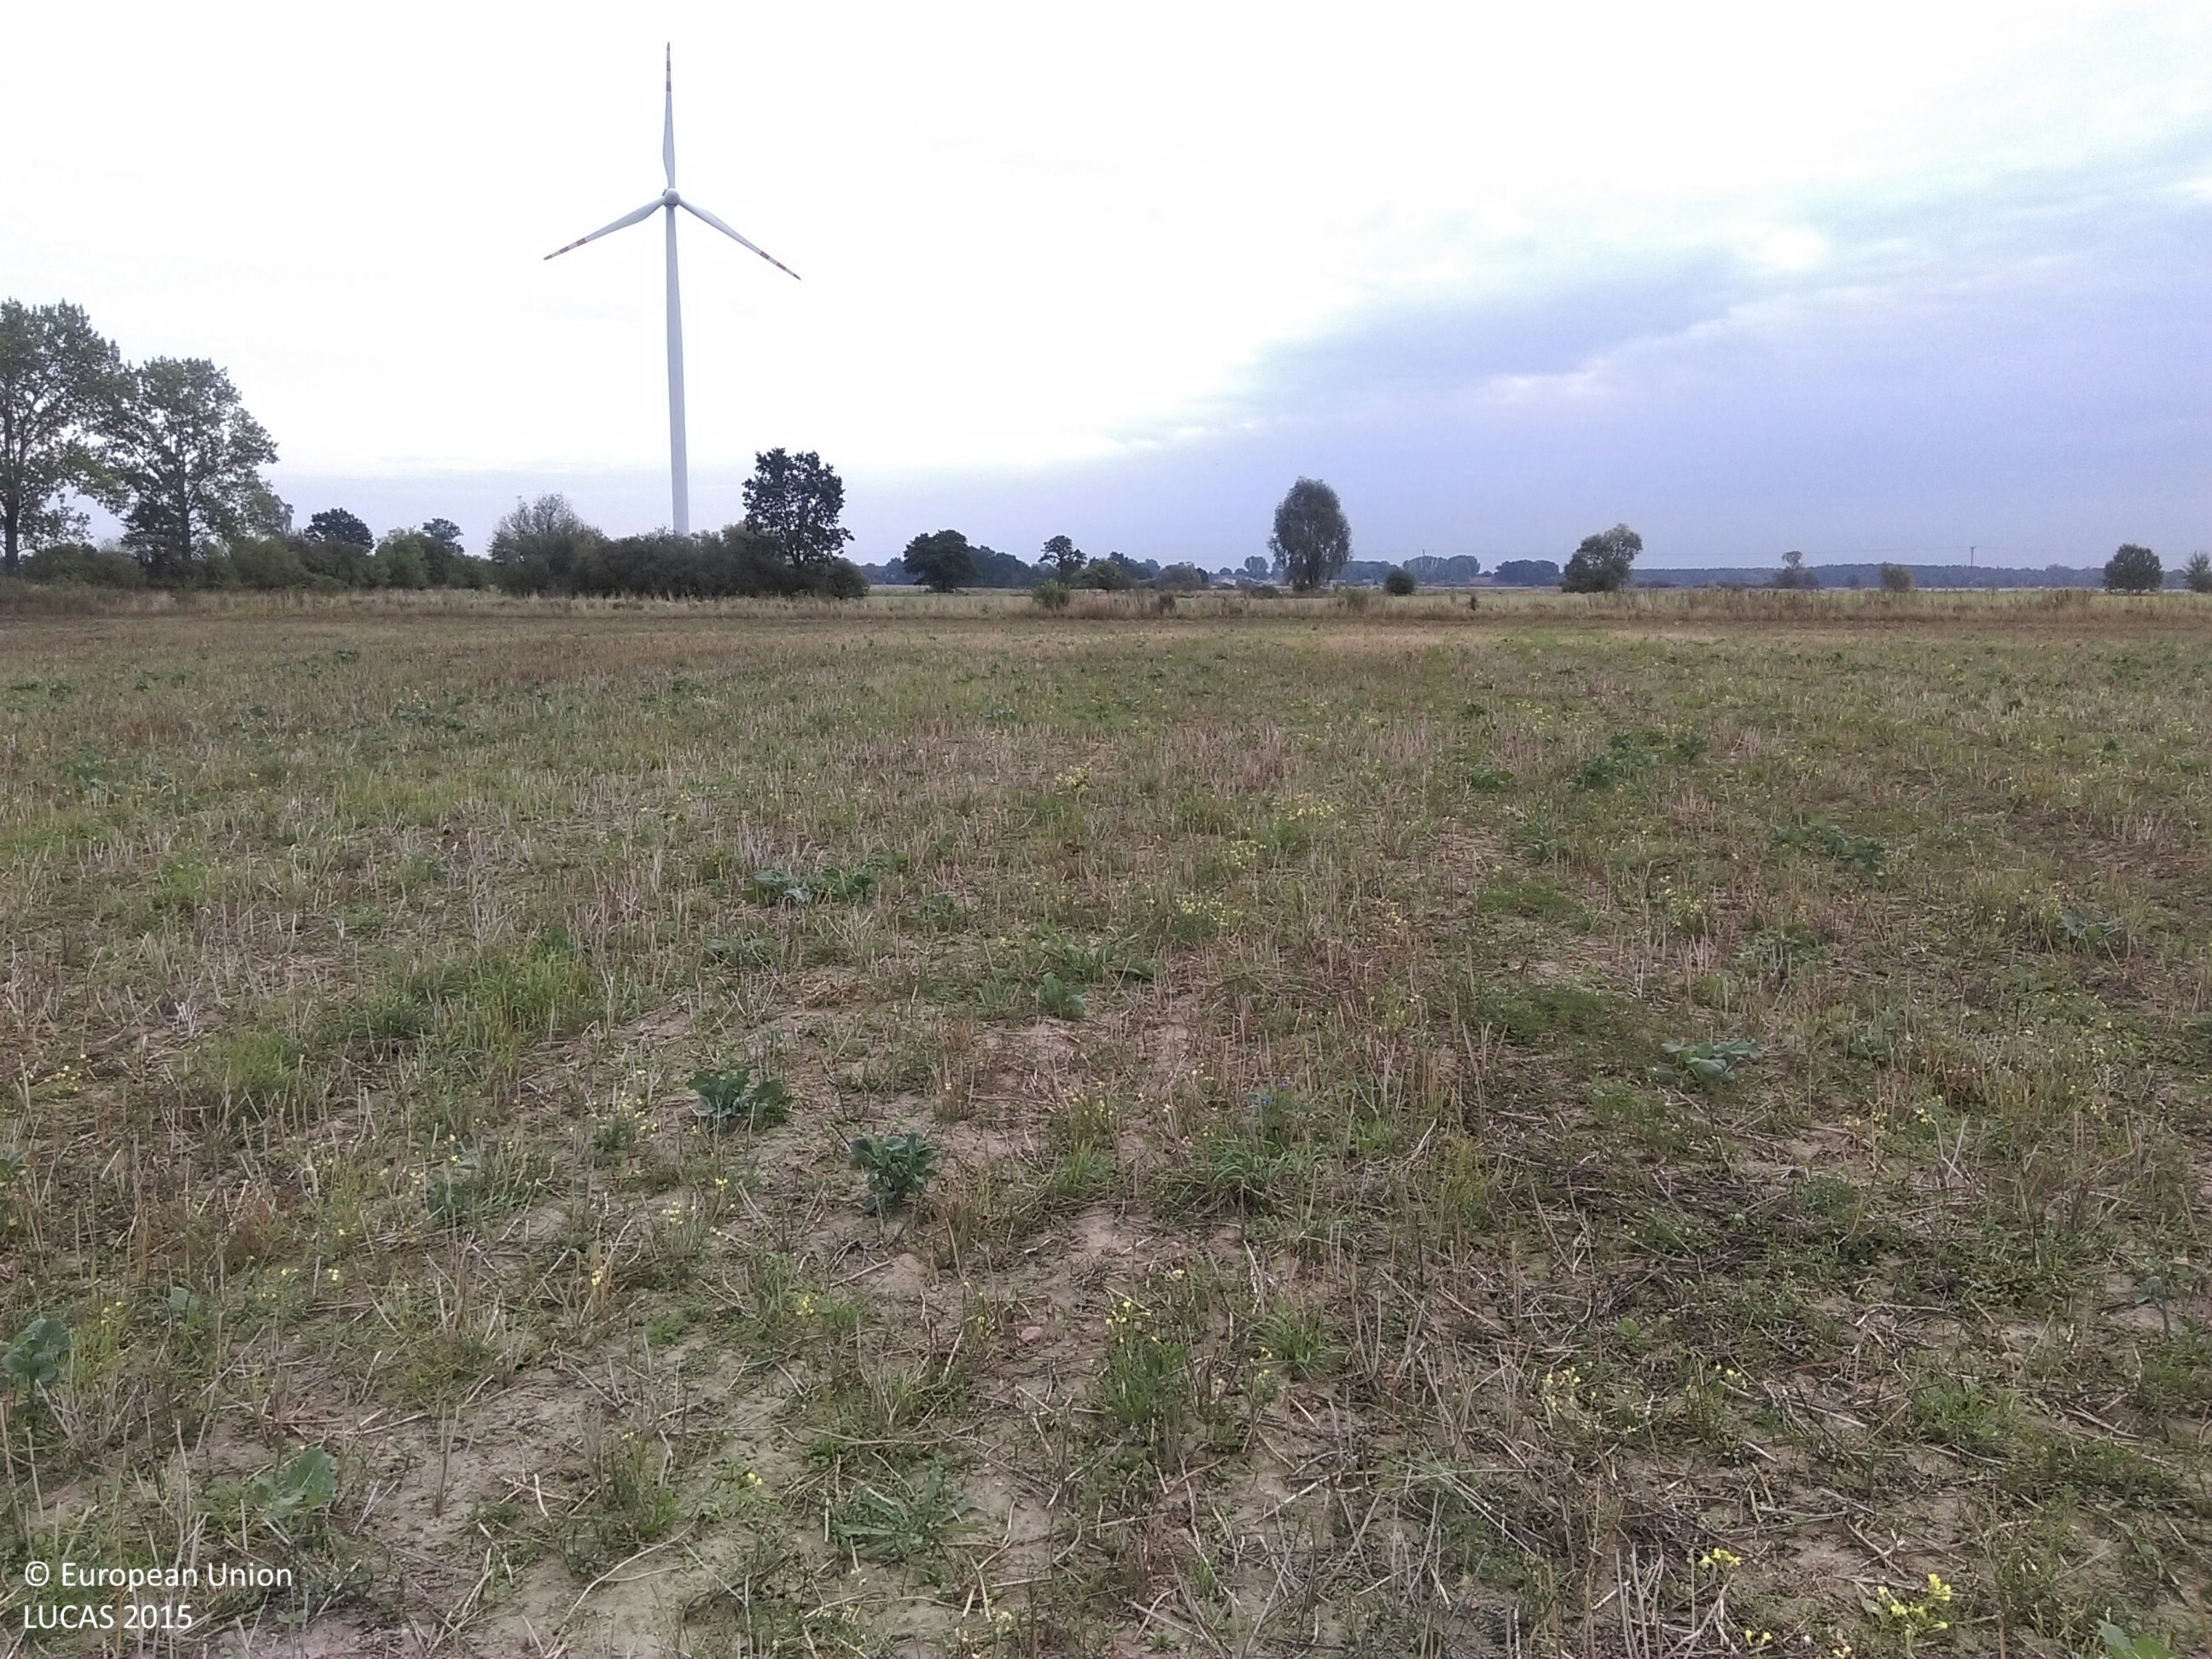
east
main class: Cropland
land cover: Rape and turnip rape
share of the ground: < 10 %
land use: Agriculture (excluding fallow land and kitchen gardens)
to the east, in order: Rape and turnip rape; Spontaneously vegetated surfaces; Tracks; Grass margins; Rape and turnip rape; Broadleaved woodland; Rape and turnip rape
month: September
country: PL
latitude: 51.5998
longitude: 15.5337
